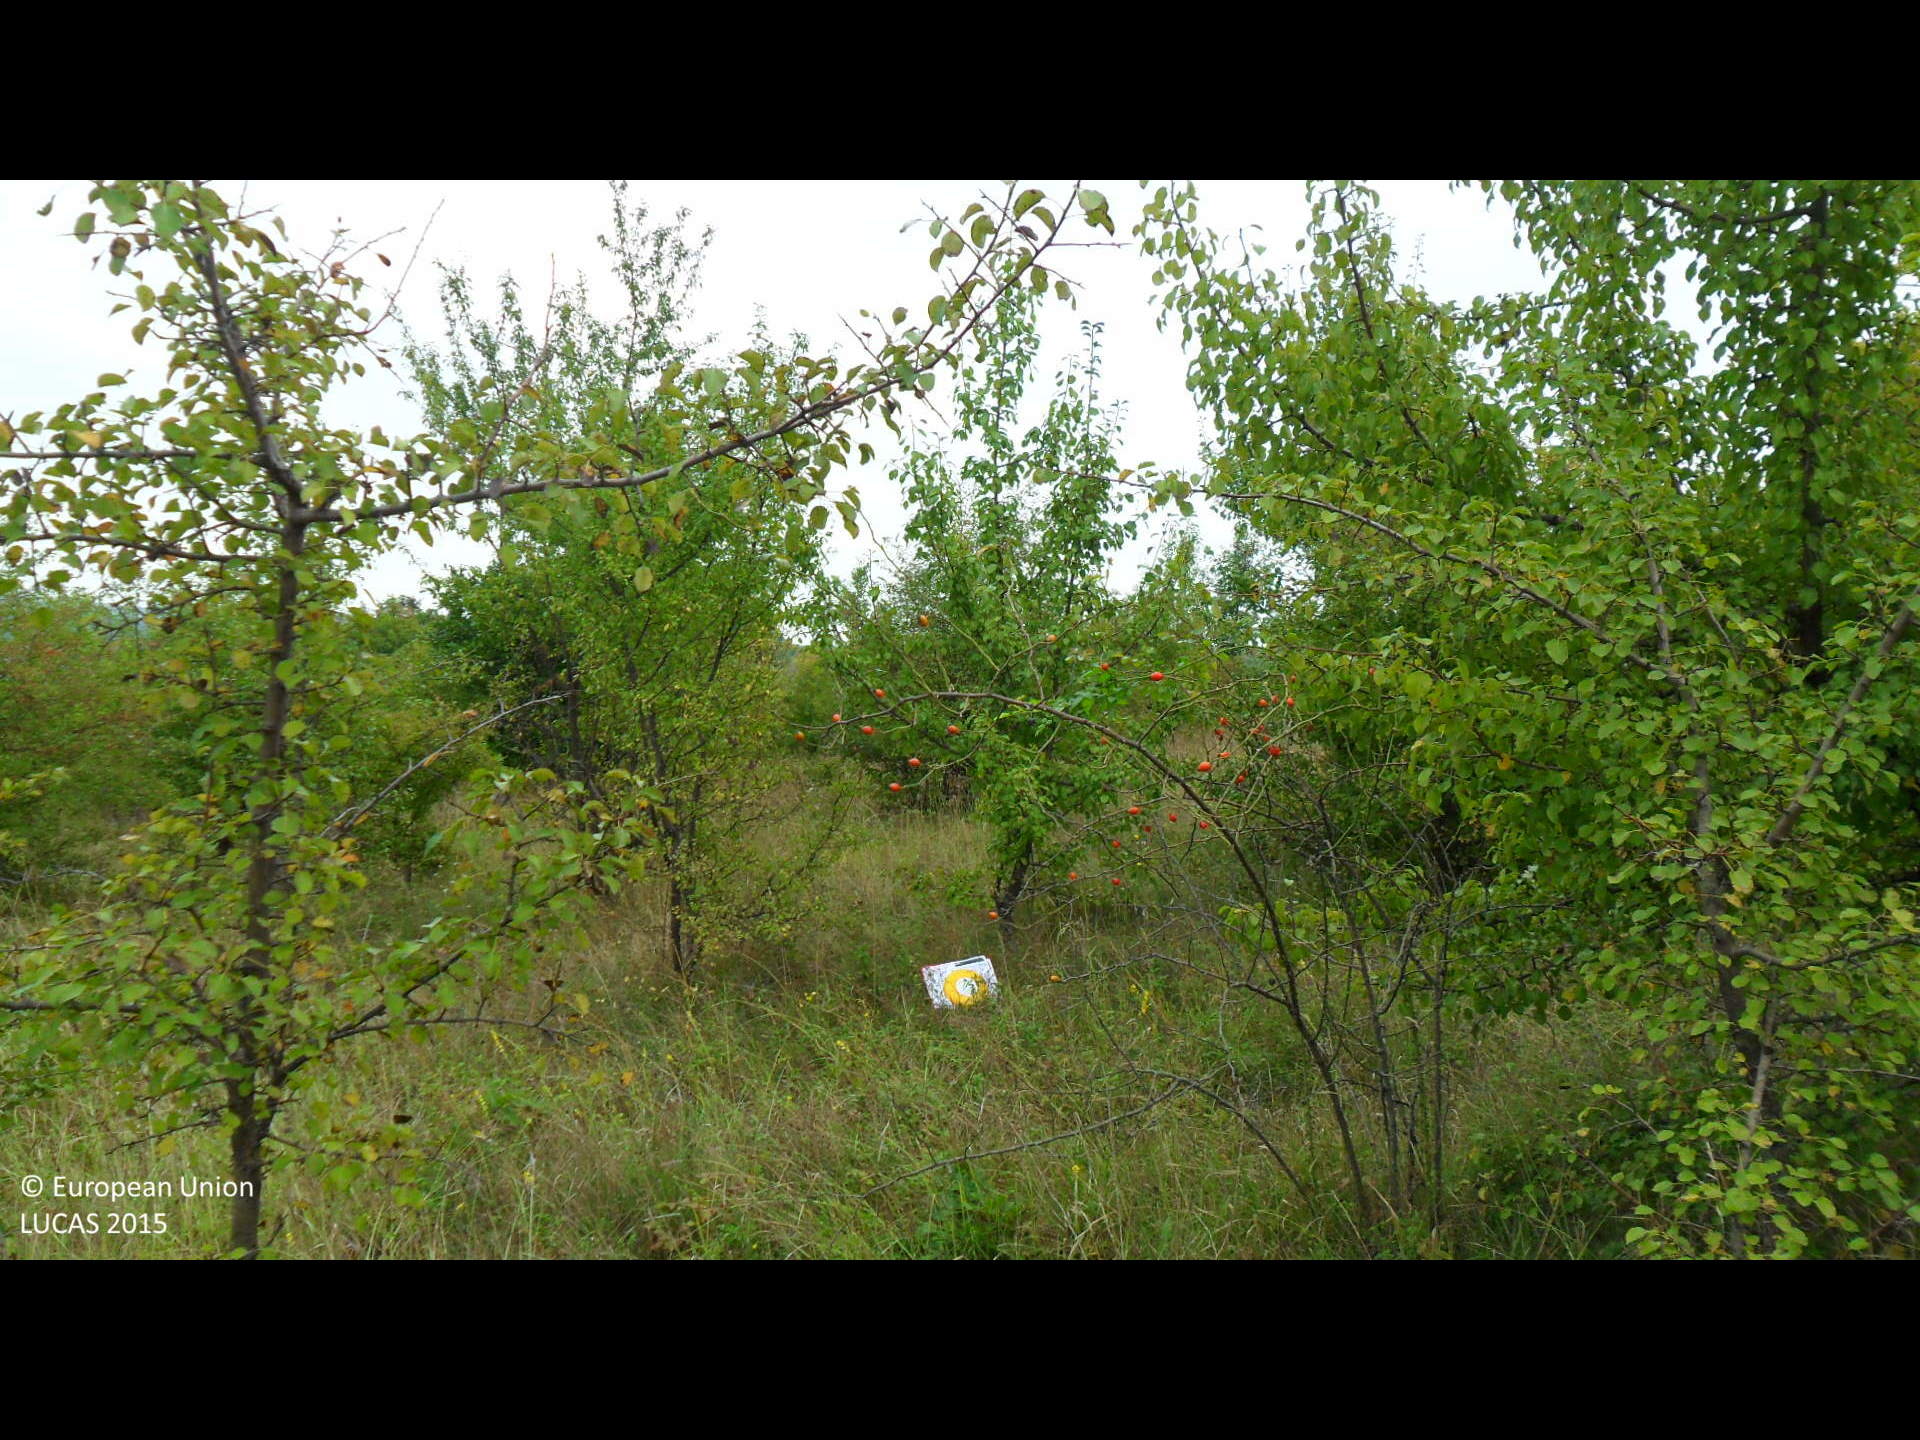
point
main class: Grassland
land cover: Grassland with sparse tree/shrub cover
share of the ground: > 75 %
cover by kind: herbaceous plants 90 %, broadleaved forest trees 5 %, shrubs 5 %
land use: Semi-natural and natural areas not in use
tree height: < 5 m
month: September
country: BG
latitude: 43.2676
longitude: 26.0964
